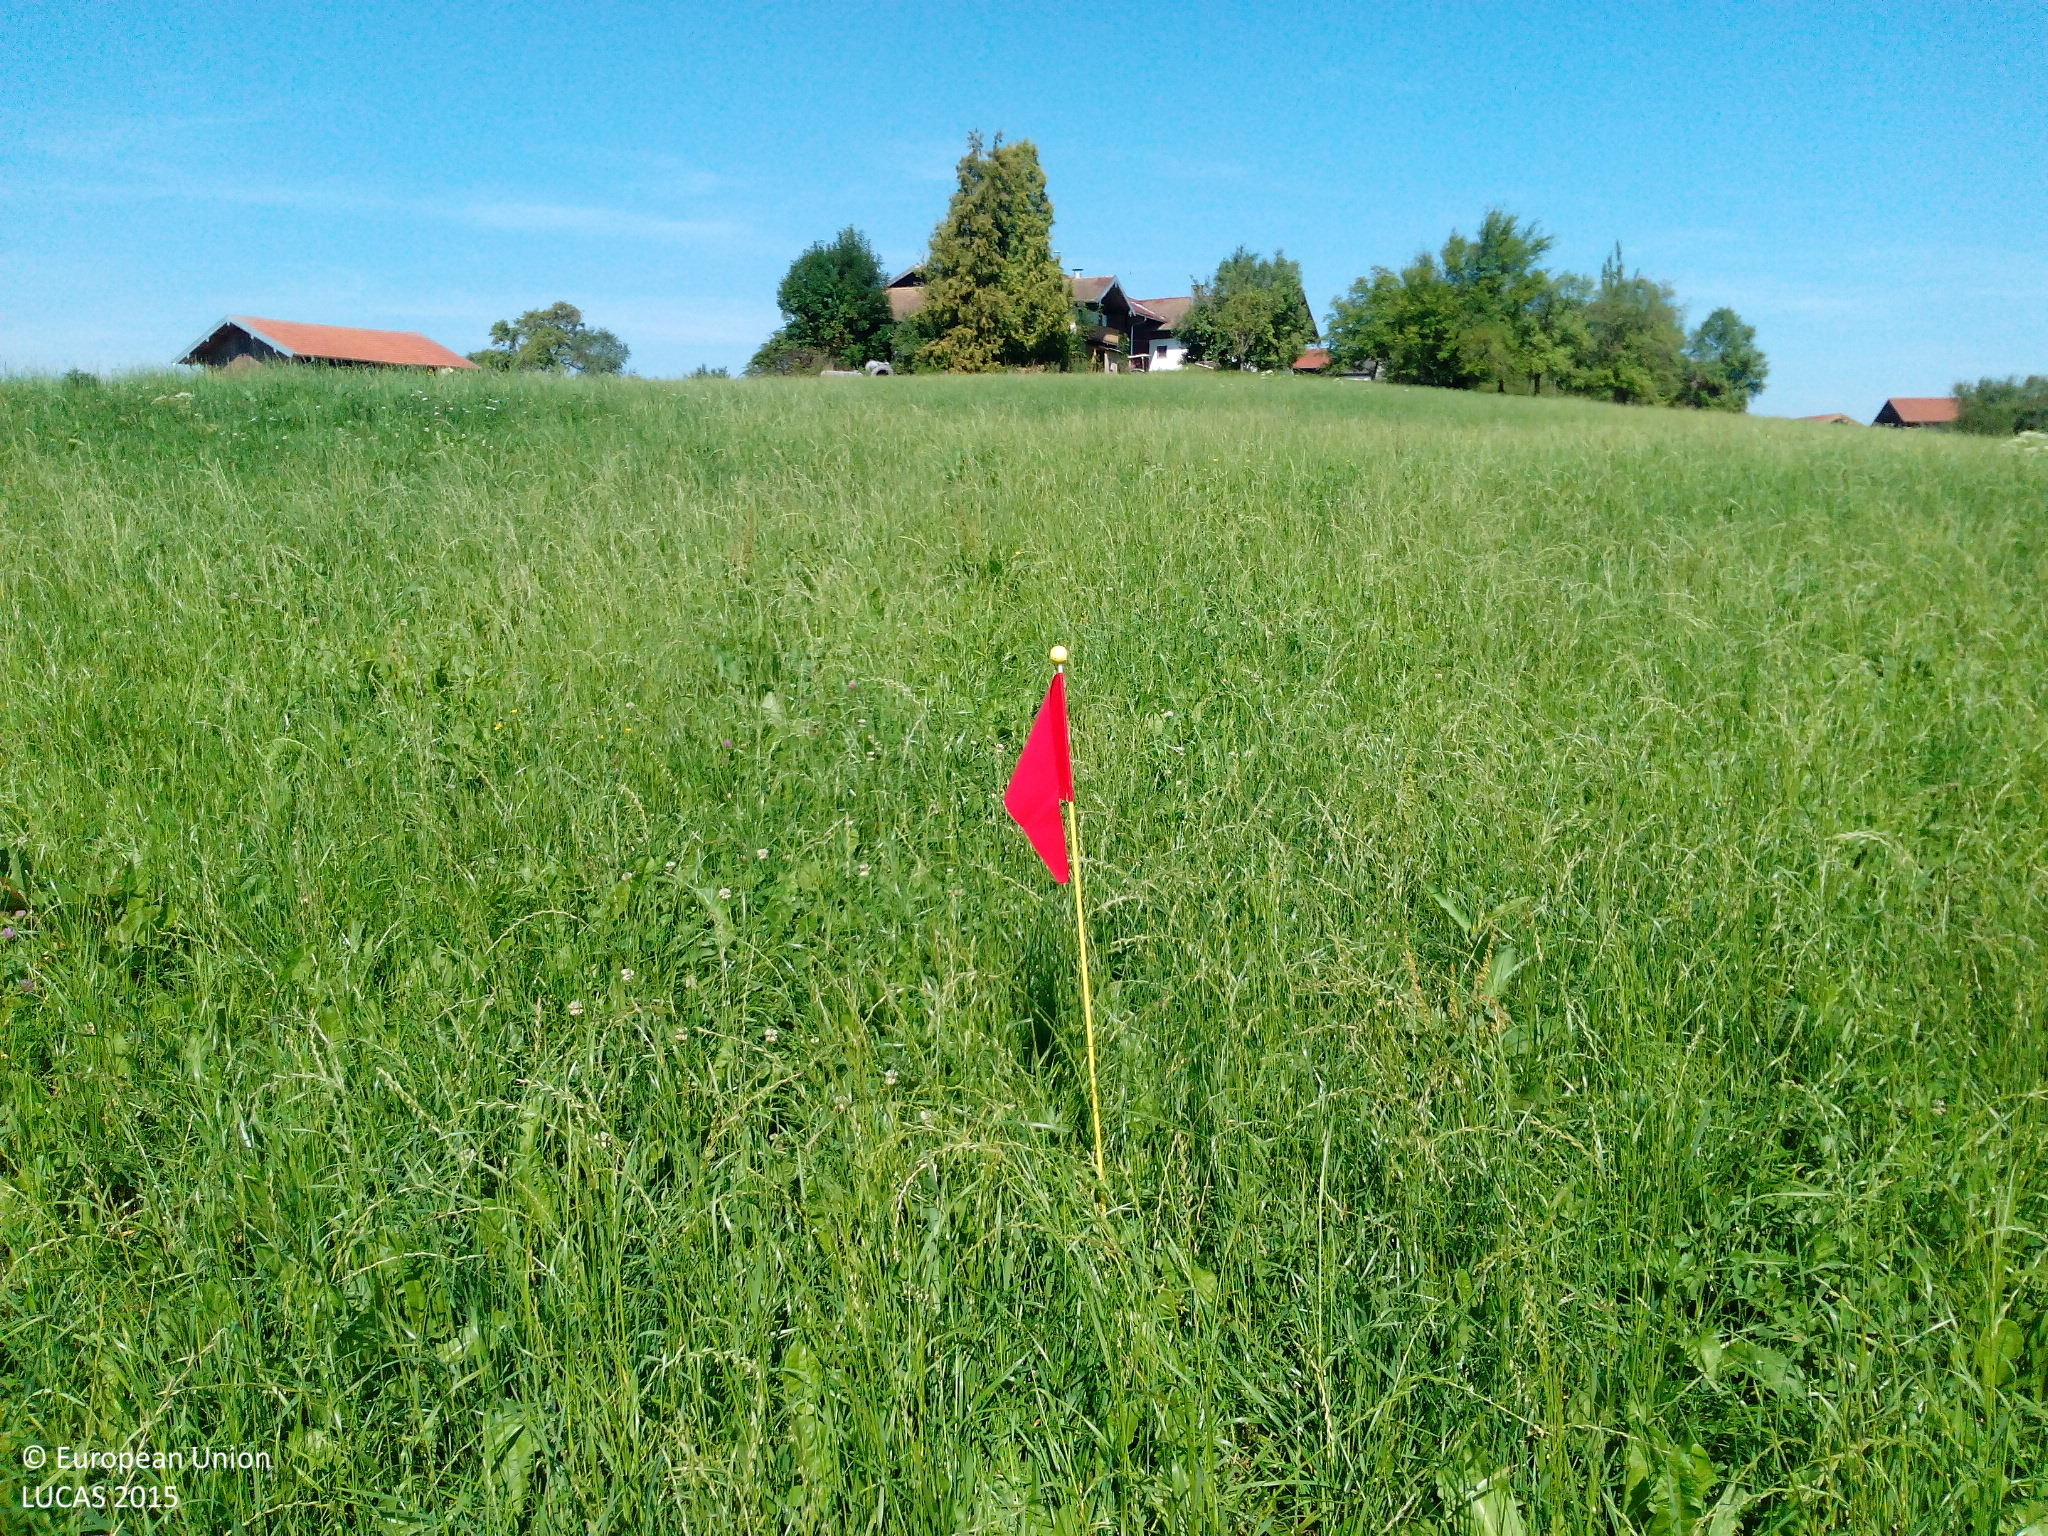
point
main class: Grassland
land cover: Grassland without tree/shrub cover
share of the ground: > 75 %
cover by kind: herbaceous plants 100 %
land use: Agriculture (excluding fallow land and kitchen gardens)
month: August
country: DE
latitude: 47.9000
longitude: 12.7944
